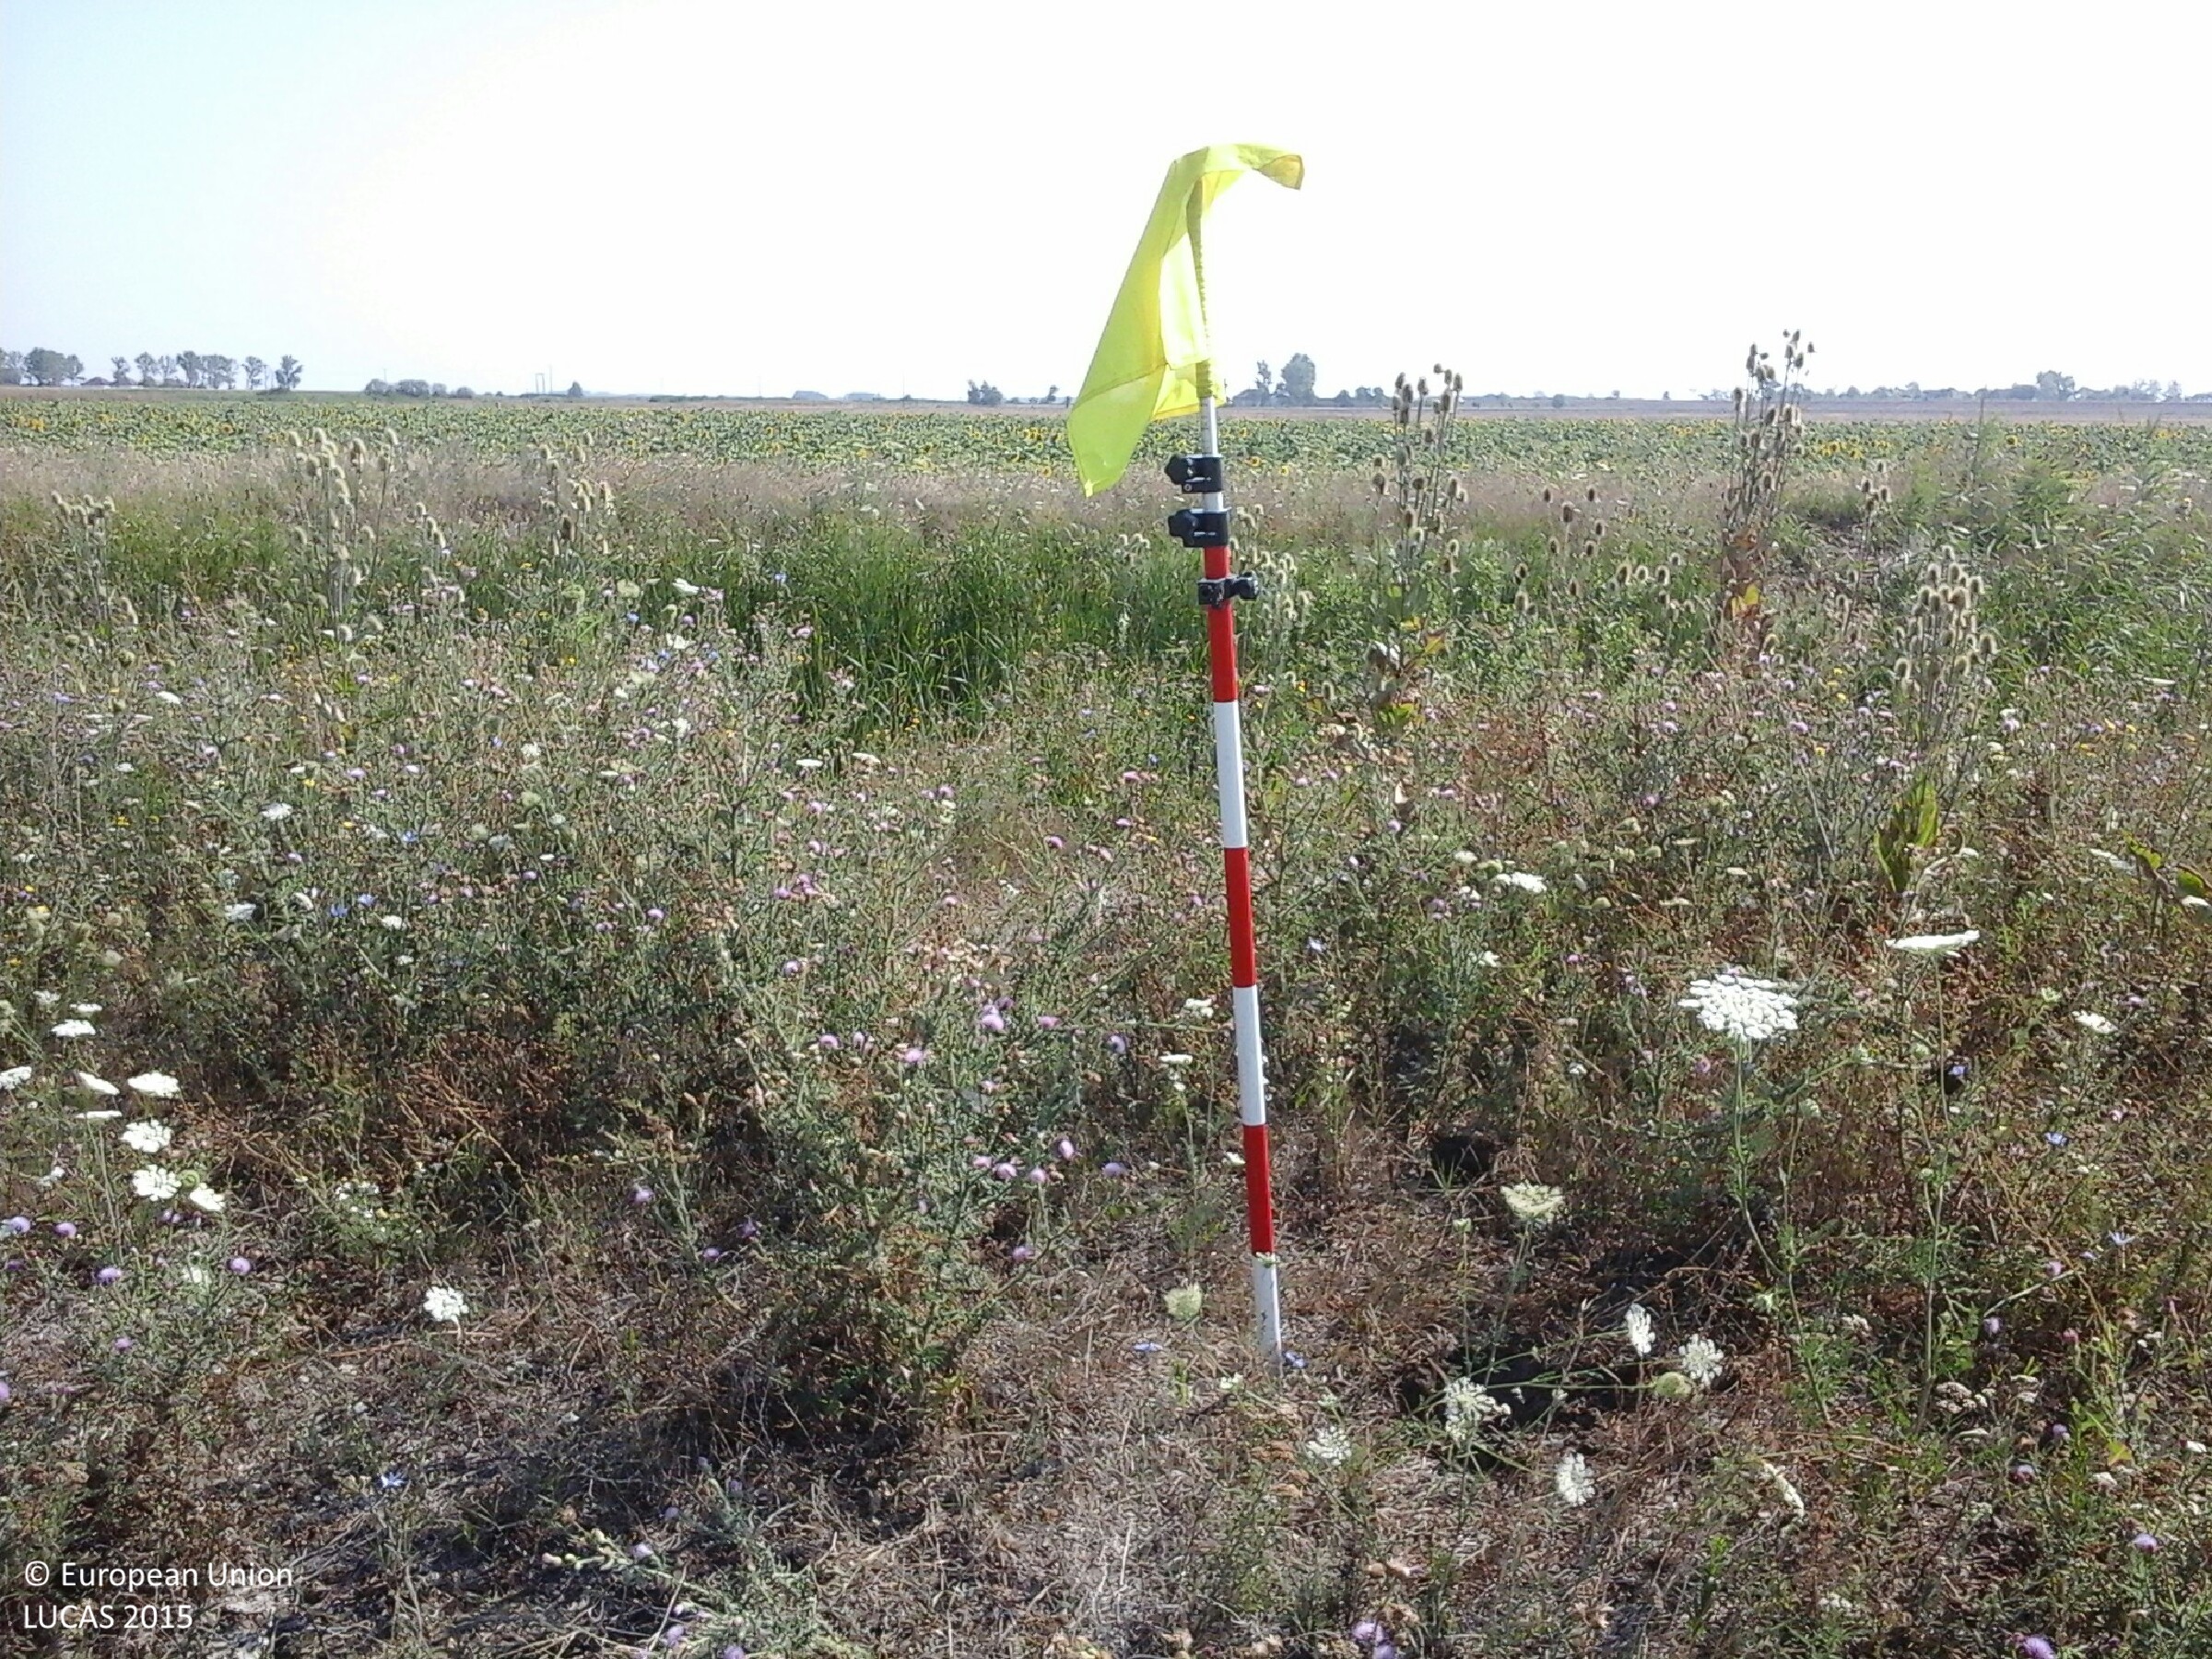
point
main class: Grassland
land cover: Grassland without tree/shrub cover
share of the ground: > 75 %
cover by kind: herbaceous plants 100 %
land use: Agriculture (excluding fallow land and kitchen gardens)
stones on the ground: < 10 %
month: August
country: HU
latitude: 47.2217
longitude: 20.9560
